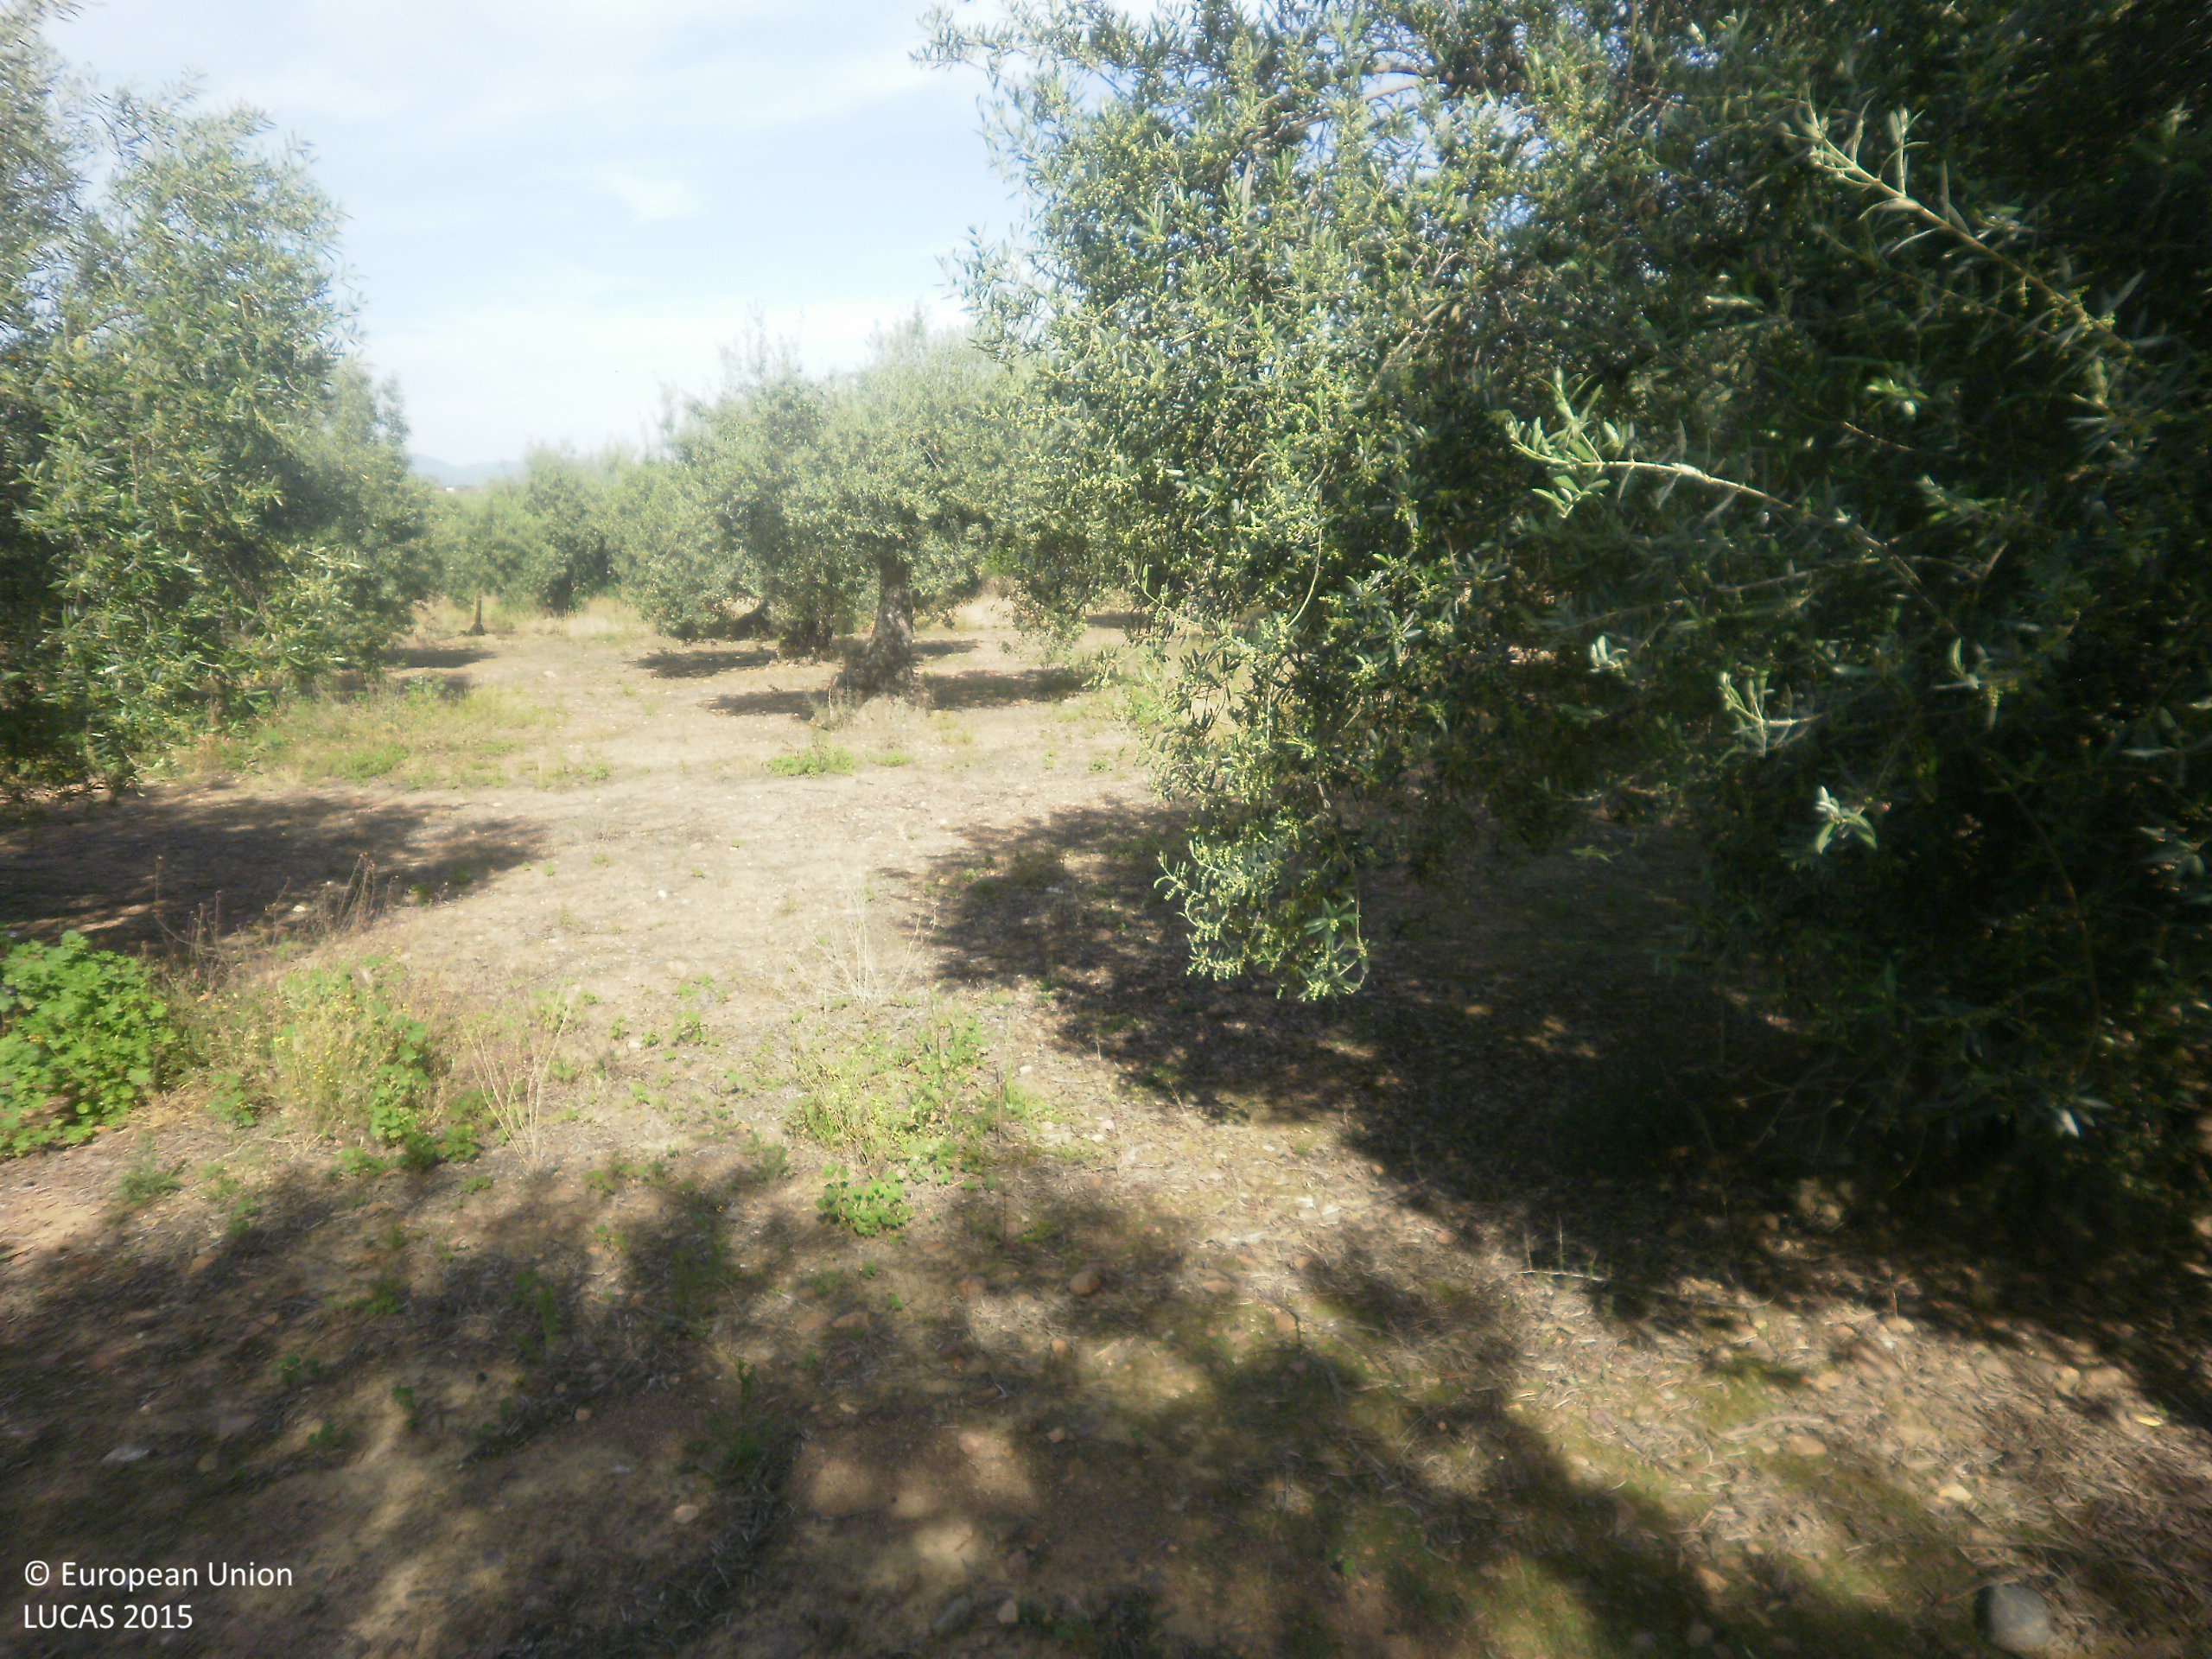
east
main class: Cropland
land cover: Olive groves
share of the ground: 50 - 75 %
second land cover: Grassland without tree/shrub cover
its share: 50 - 75 %
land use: Agriculture (excluding fallow land and kitchen gardens)
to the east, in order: Olive groves; Grassland without tree/shrub cover; Artificial constructions in urban areas; Tracks; Olive groves; Dry stone walls; Grassland with sparse tree/shrub cover
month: April
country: ES
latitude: 38.9909
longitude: -5.2679
